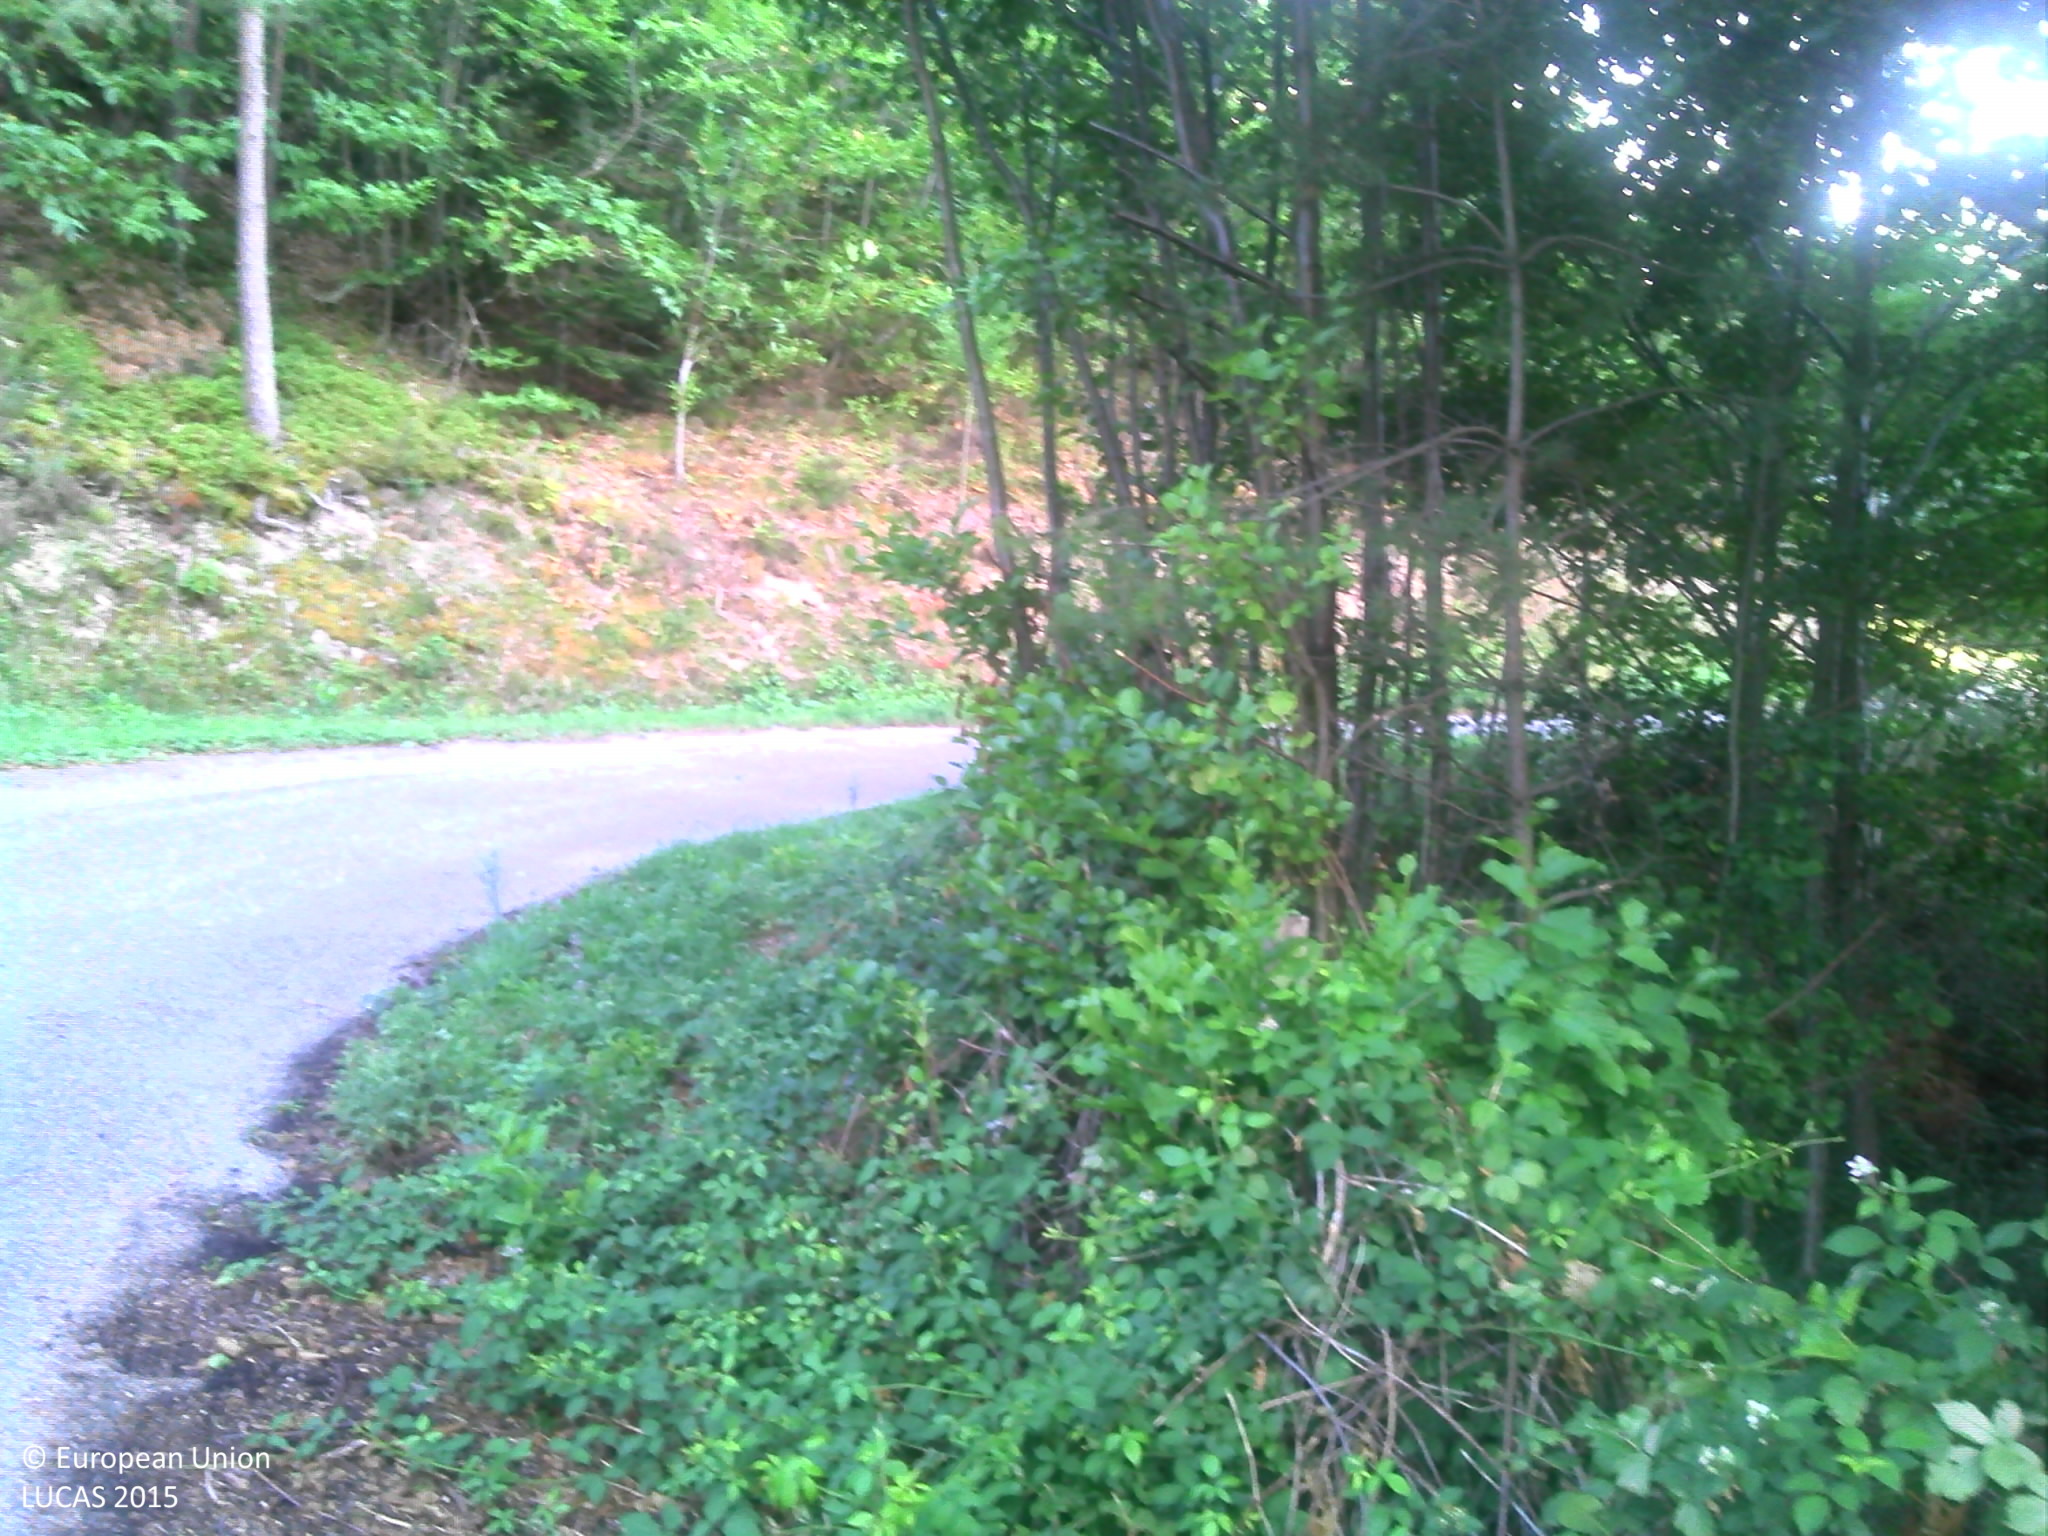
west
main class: Woodland
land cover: Broadleaved woodland
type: floodplain forest
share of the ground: > 75 %
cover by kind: broadleaved forest trees 80 %, shrubs 20 %
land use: Semi-natural and natural areas not in use
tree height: > 5 m
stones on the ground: < 10 %
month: September
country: FR
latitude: 45.1482
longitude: 4.5740
